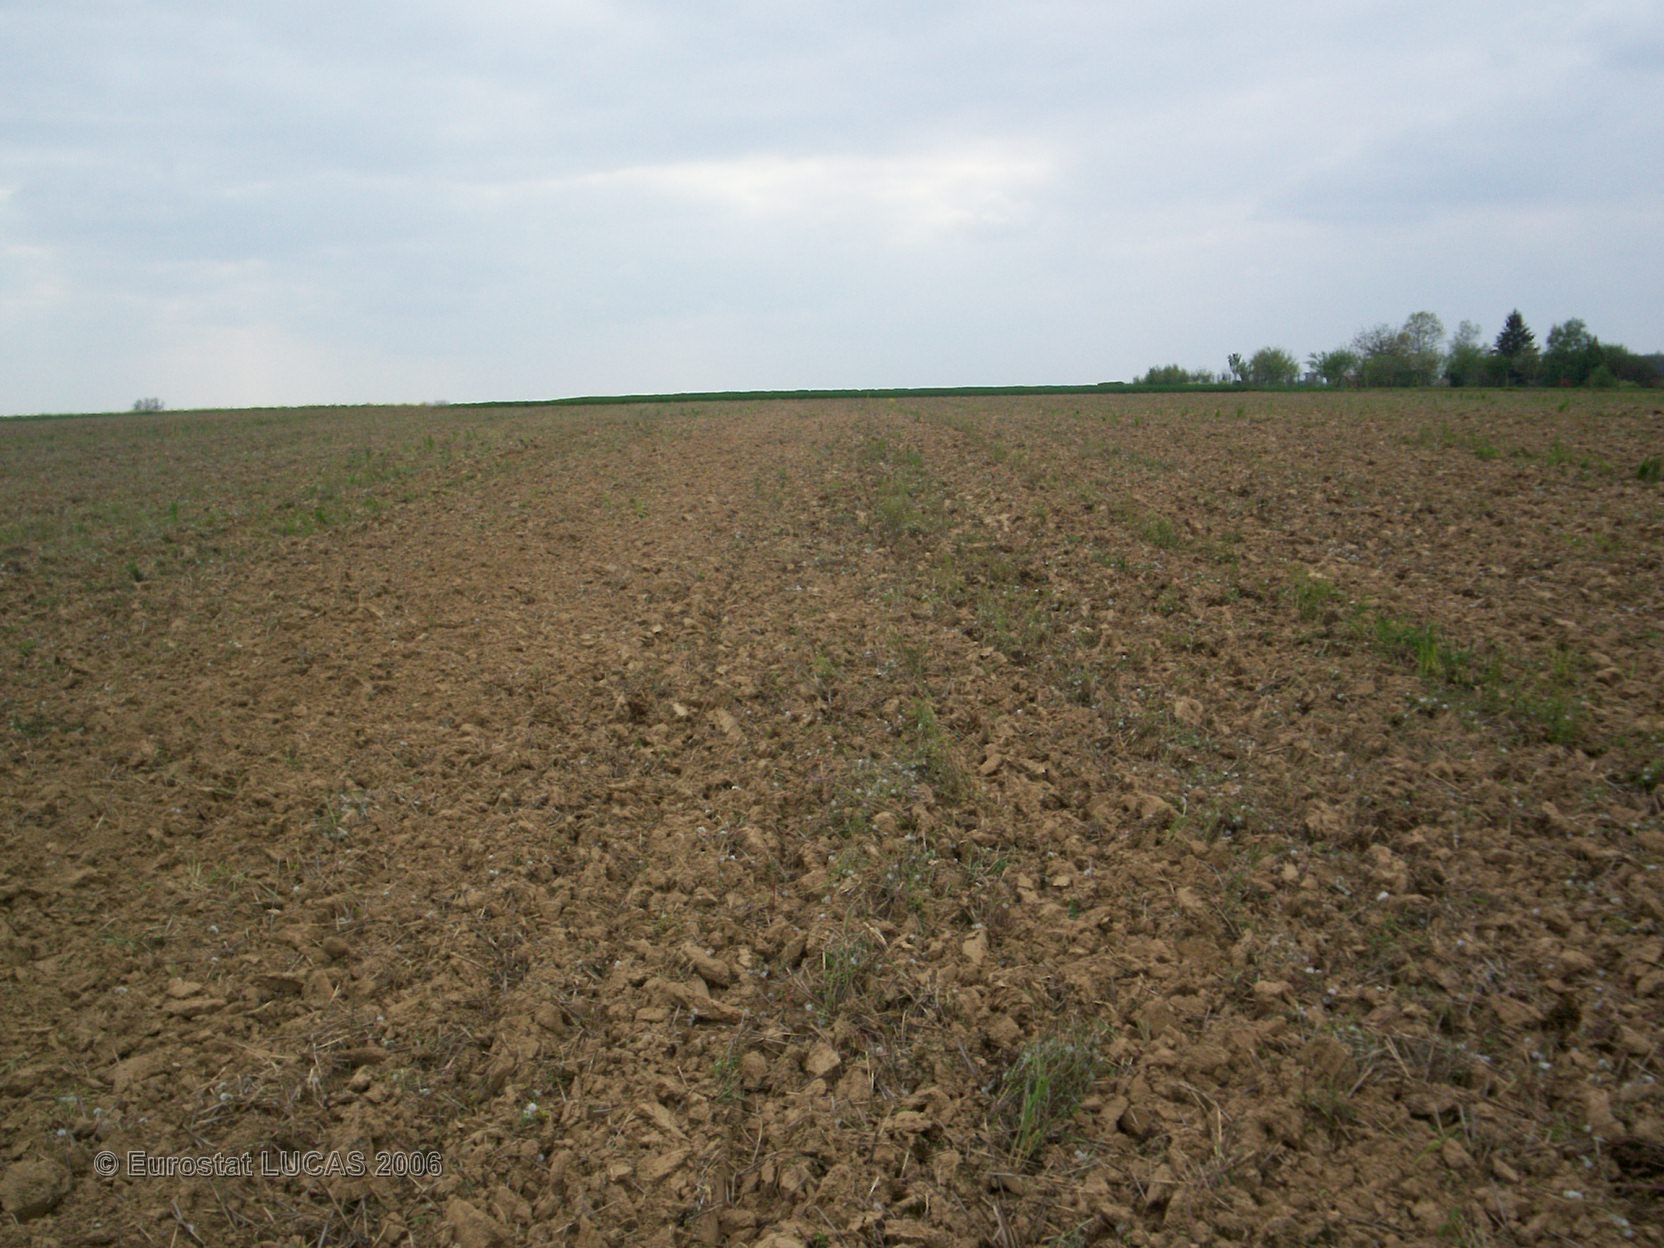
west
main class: Cropland
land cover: Maize
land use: Agriculture (excluding fallow land and kitchen gardens)
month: May
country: FR
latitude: 47.7221
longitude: 0.0955
